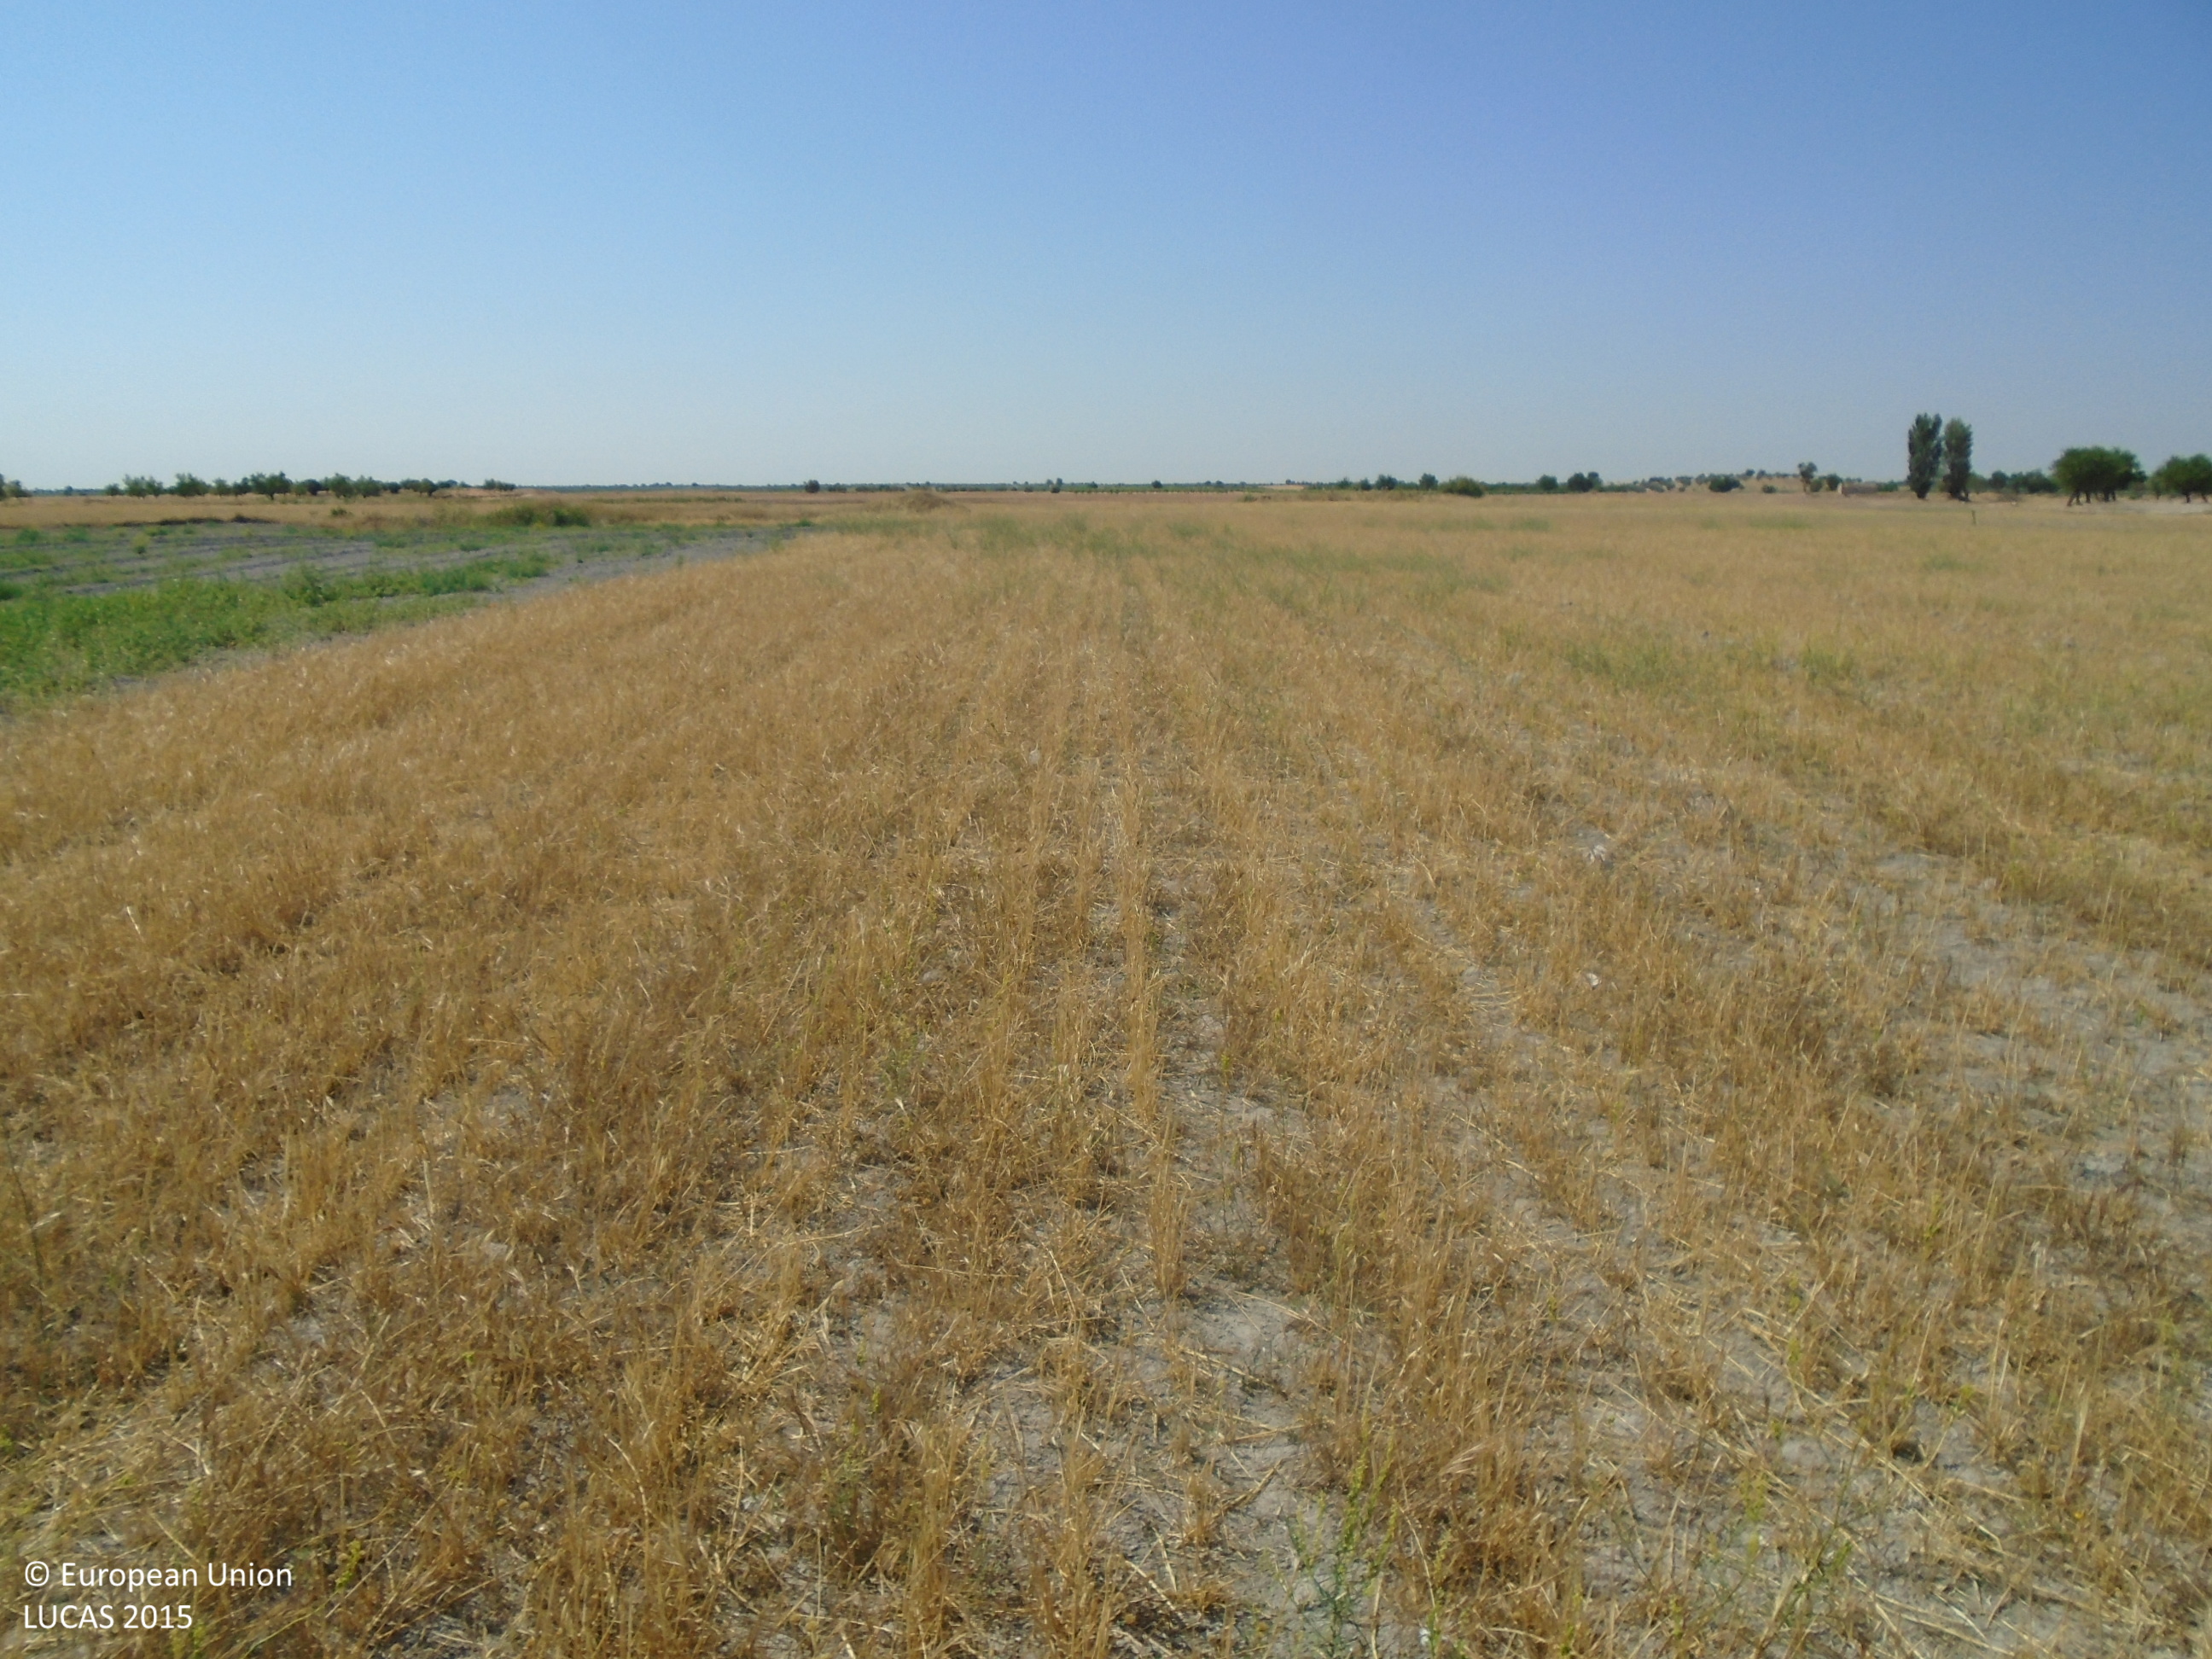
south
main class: Cropland
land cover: Barley
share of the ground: > 75 %
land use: Agriculture (excluding fallow land and kitchen gardens)
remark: Harvested field
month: June
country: ES
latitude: 39.1840
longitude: -3.6223
